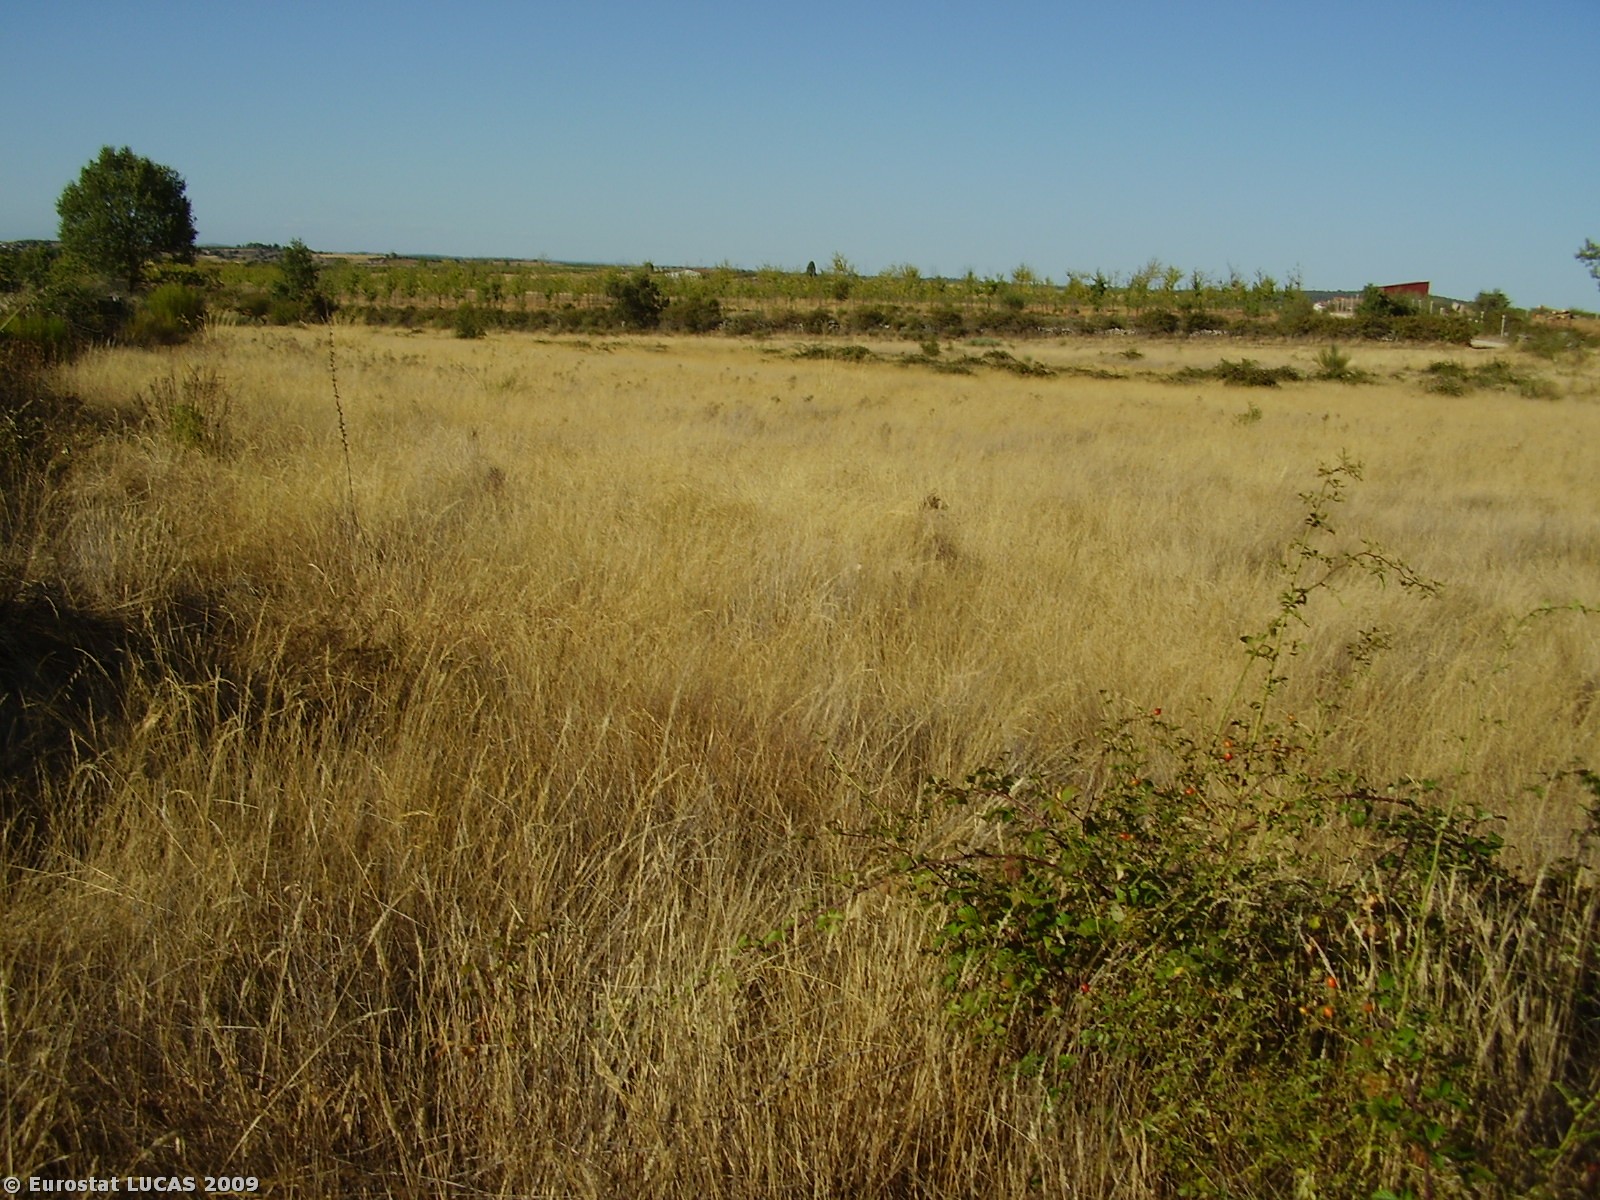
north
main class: Grassland
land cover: Spontaneously vegetated surfaces
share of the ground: > 75 %
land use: Fallow land
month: August
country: PT
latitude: 41.3905
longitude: -6.4484
